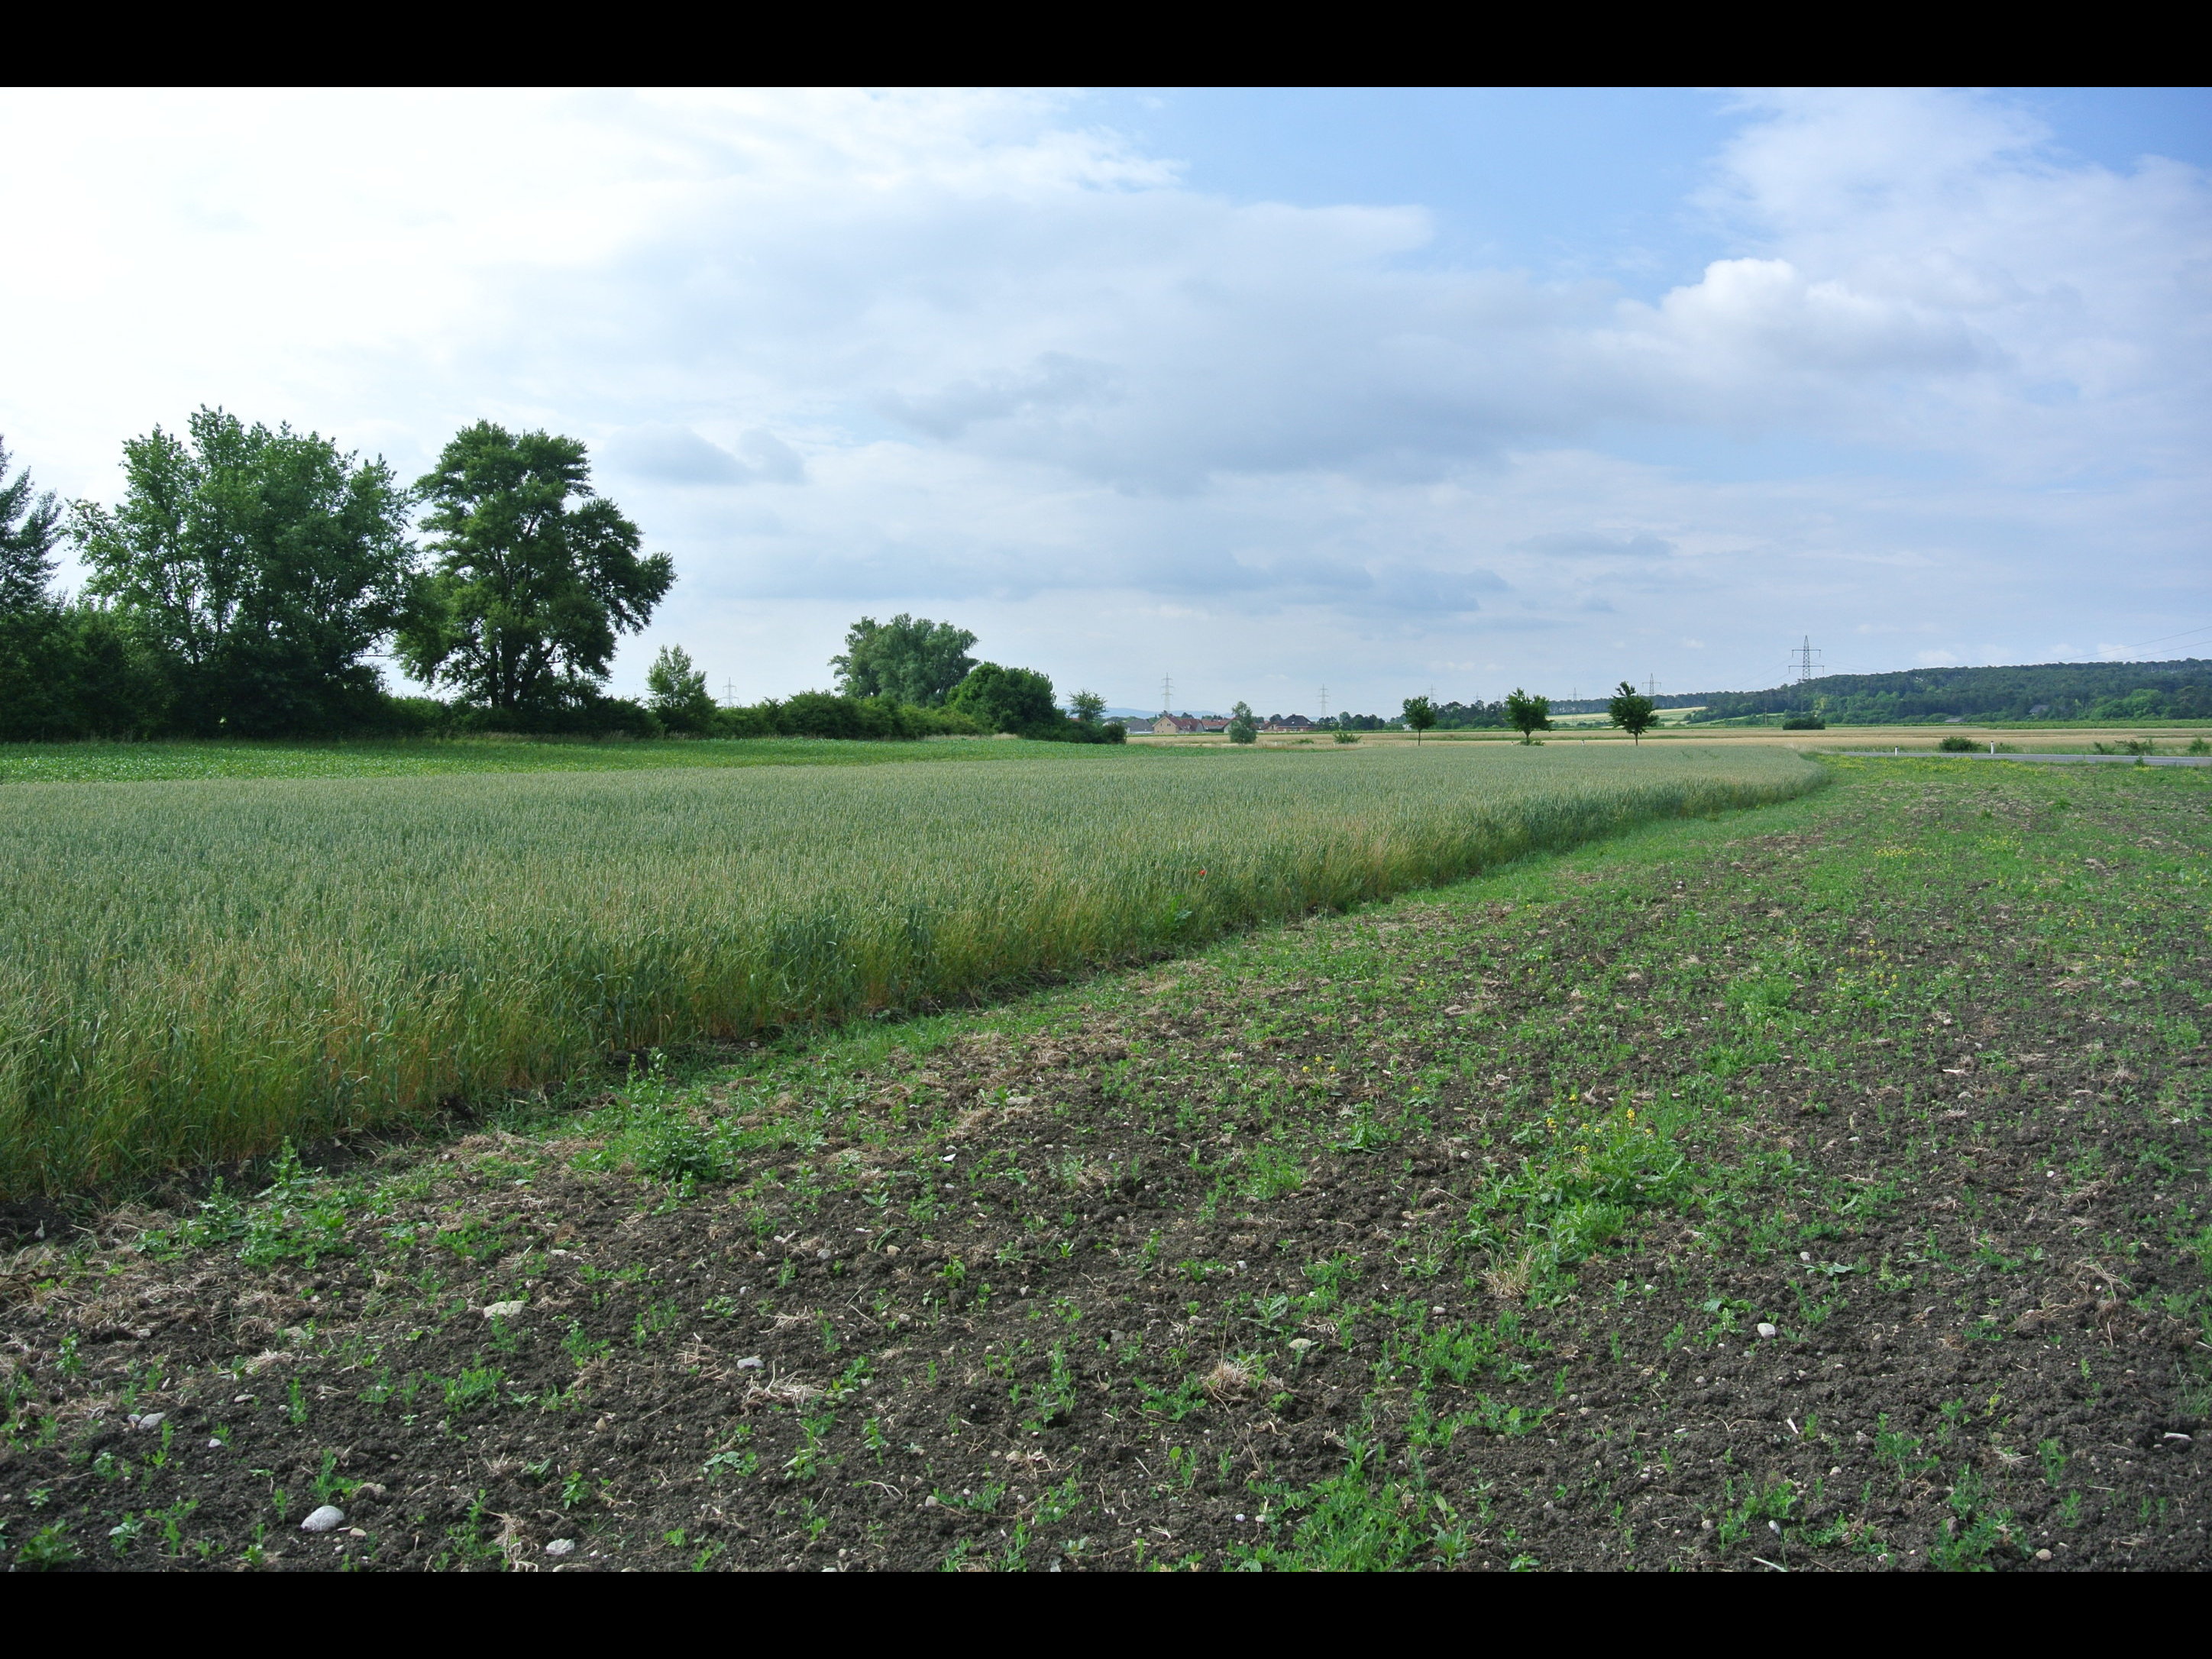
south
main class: Grassland
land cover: Spontaneously vegetated surfaces
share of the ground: 25 - 50 %
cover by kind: unconsolidated bare surface 55 %, herbaceous plants 45 %
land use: Agriculture (excluding fallow land and kitchen gardens)
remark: Harvested field
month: June
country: AT
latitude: 47.9048
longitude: 16.1978
